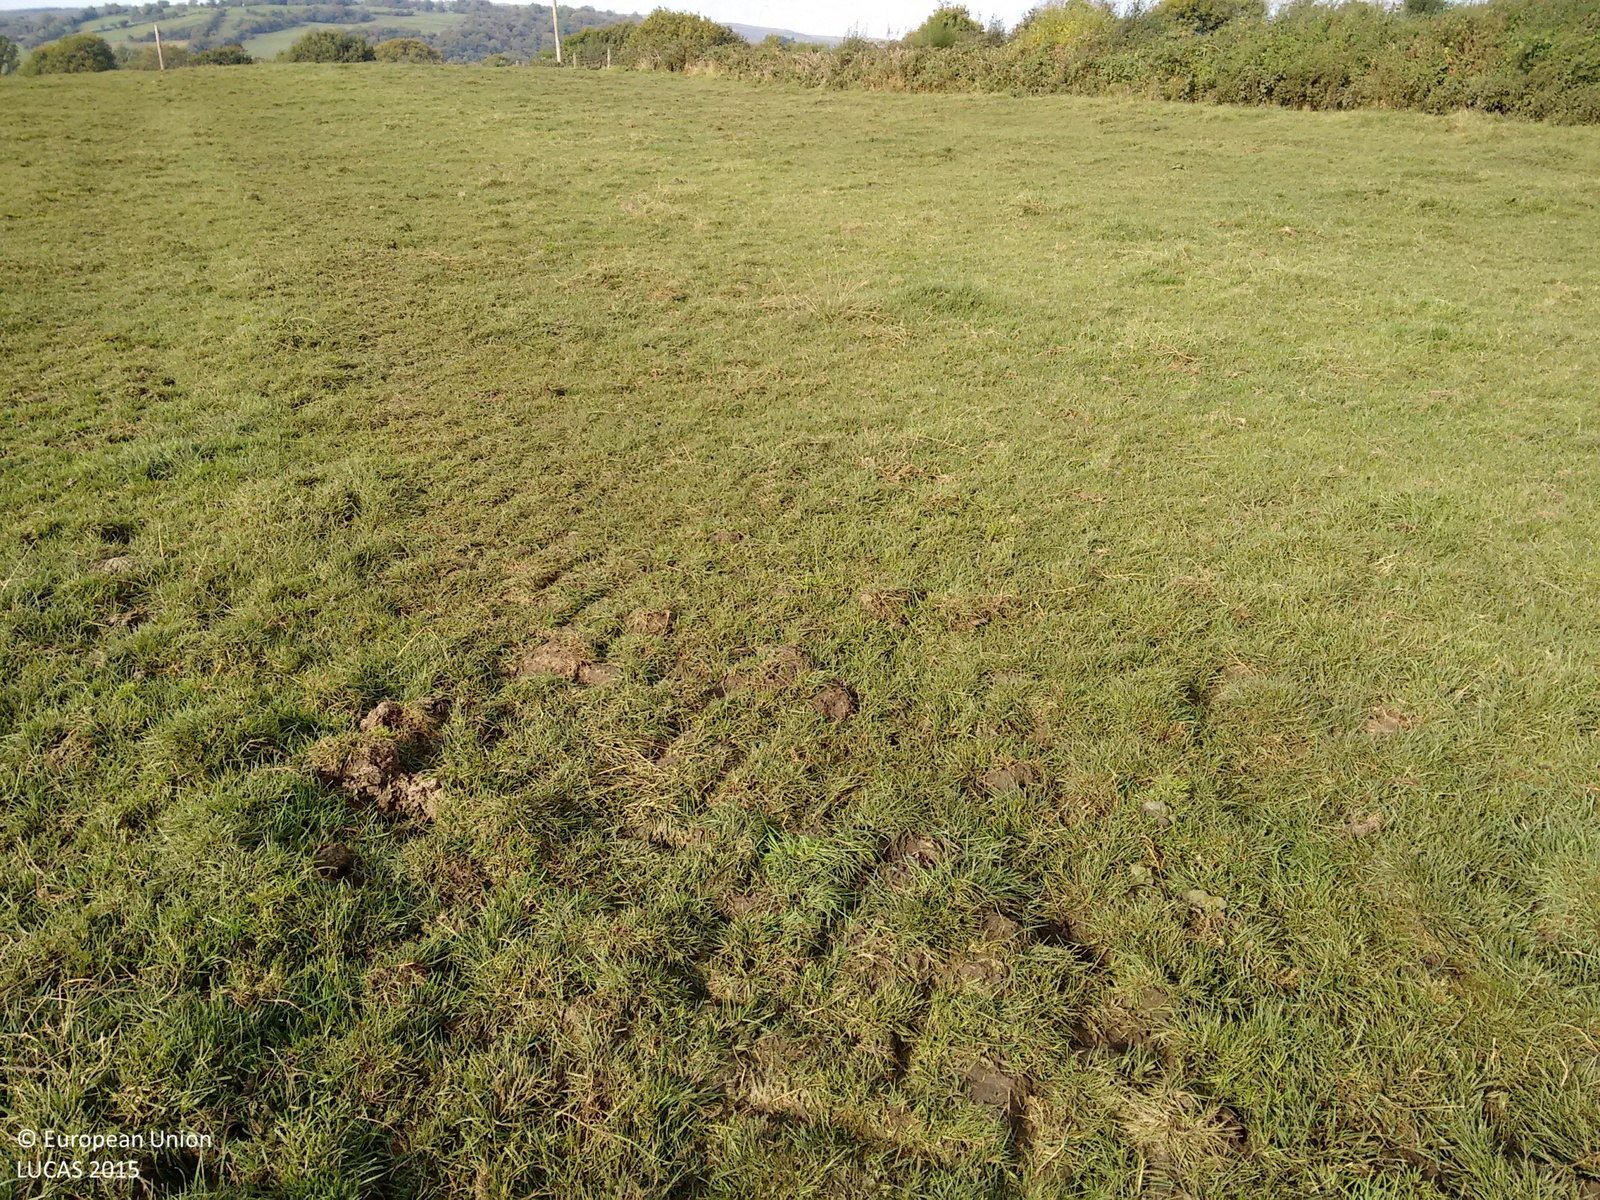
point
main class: Grassland
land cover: Grassland without tree/shrub cover
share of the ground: > 75 %
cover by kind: herbaceous plants 100 %
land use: Agriculture (excluding fallow land and kitchen gardens)
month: October
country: GB
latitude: 54.1317
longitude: -7.5594
